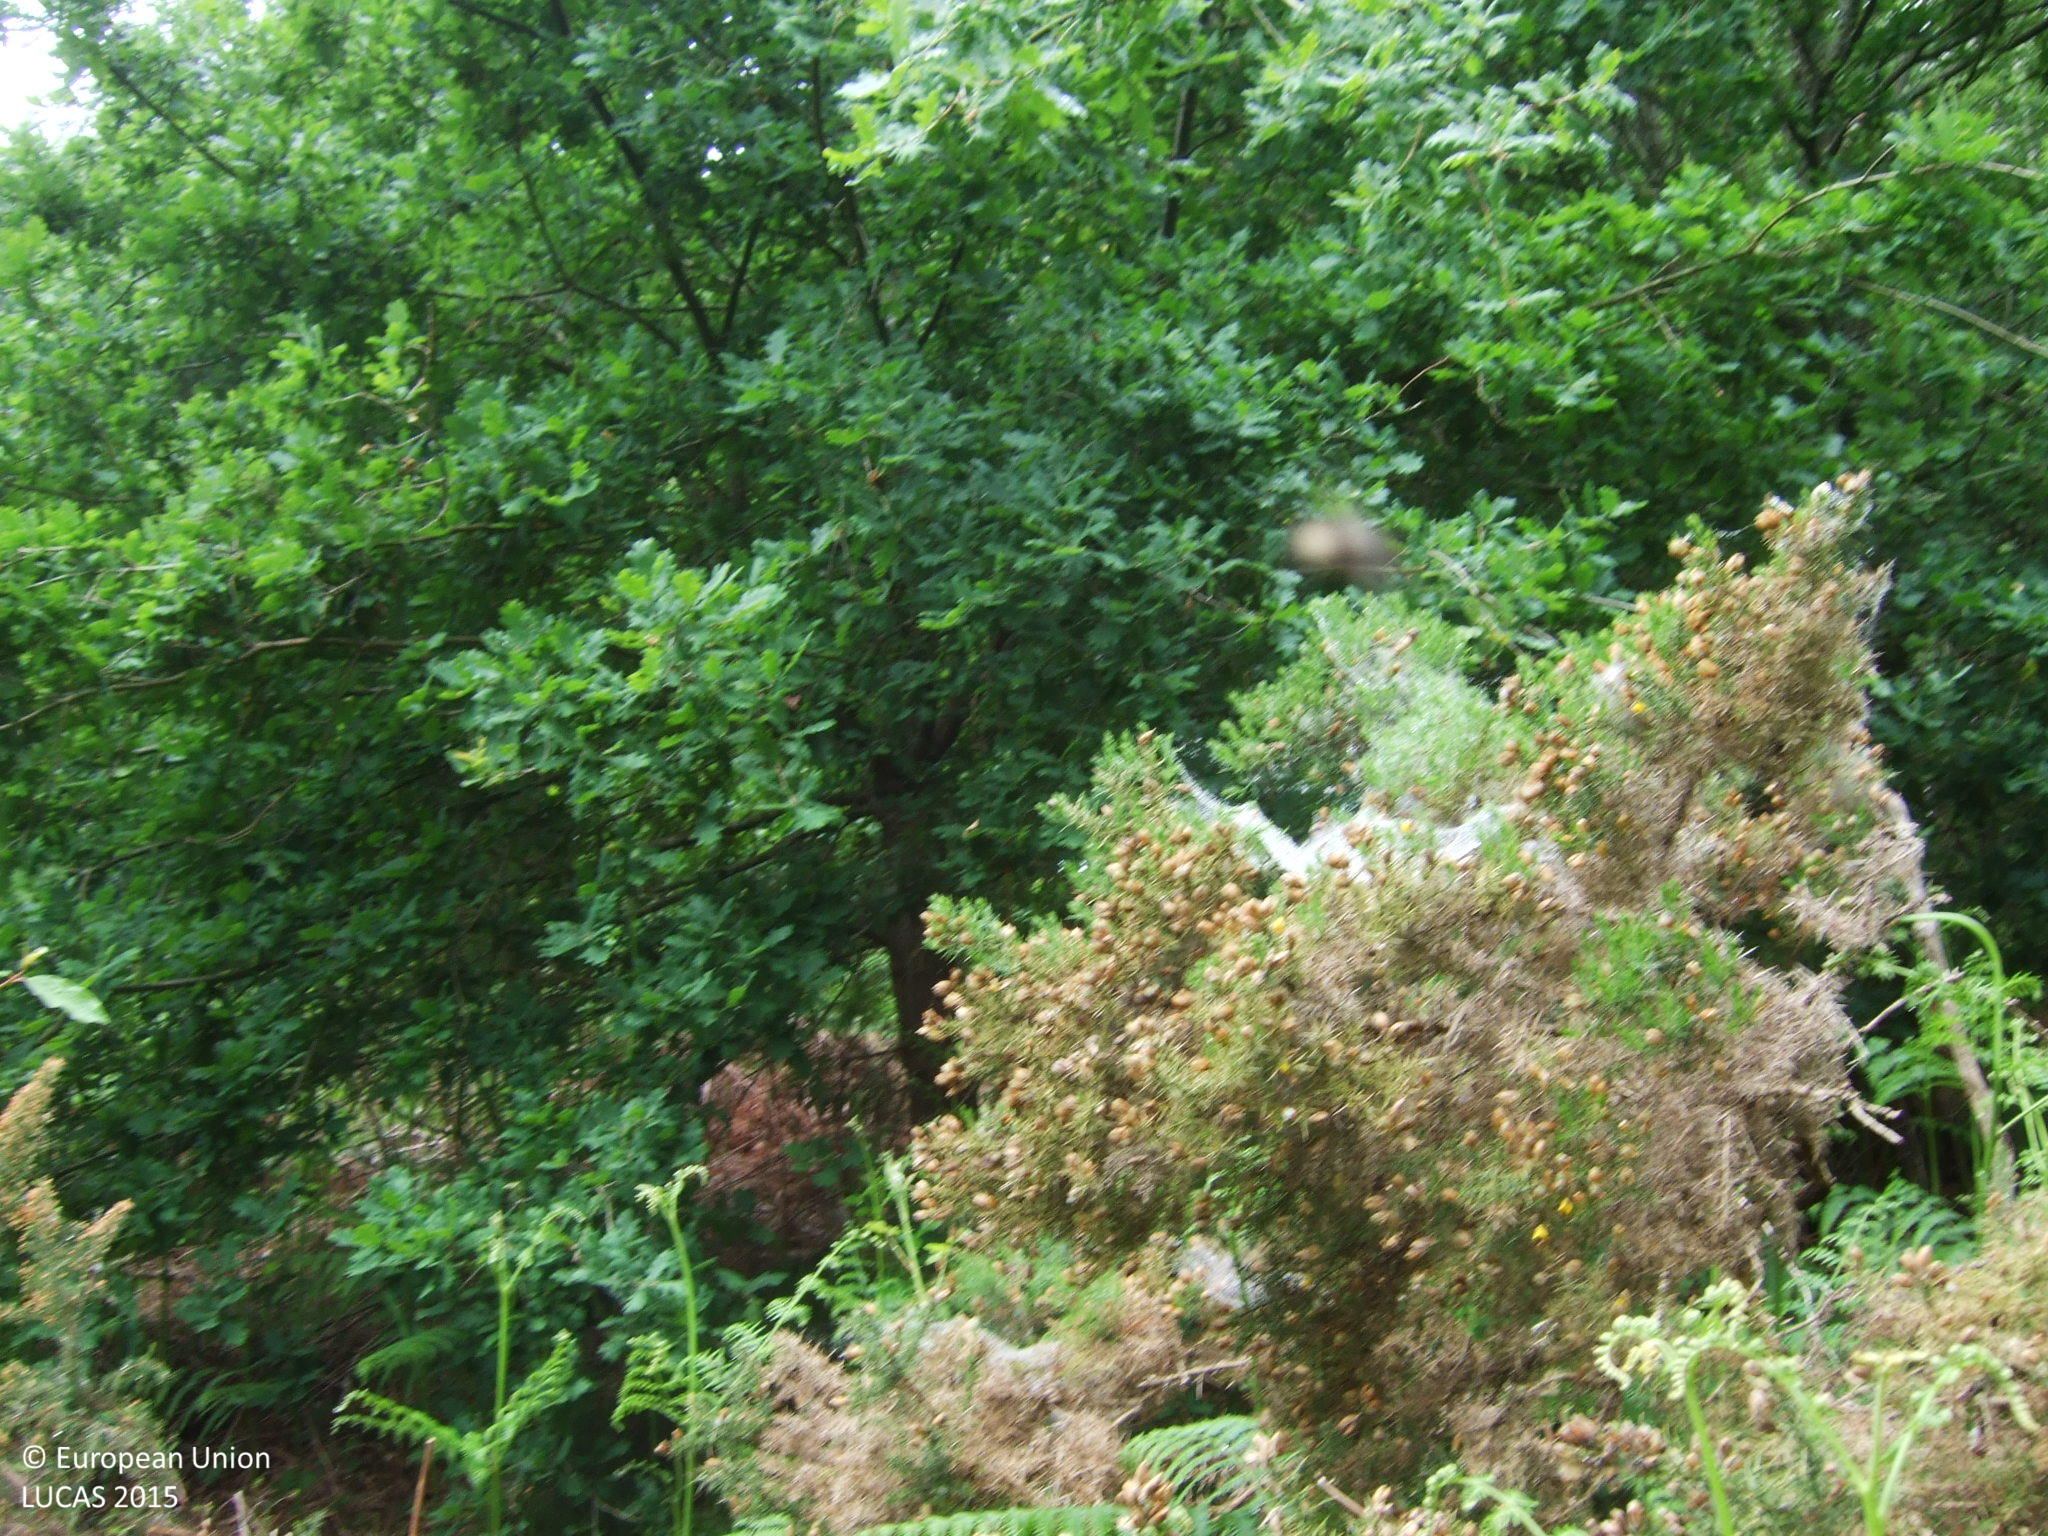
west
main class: Shrubland
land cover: Shrubland with sparse tree cover
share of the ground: > 75 %
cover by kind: shrubs 95 %, broadleaved forest trees 5 %
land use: Semi-natural and natural areas not in use
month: June
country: ES
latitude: 42.7280
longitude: -7.3494
